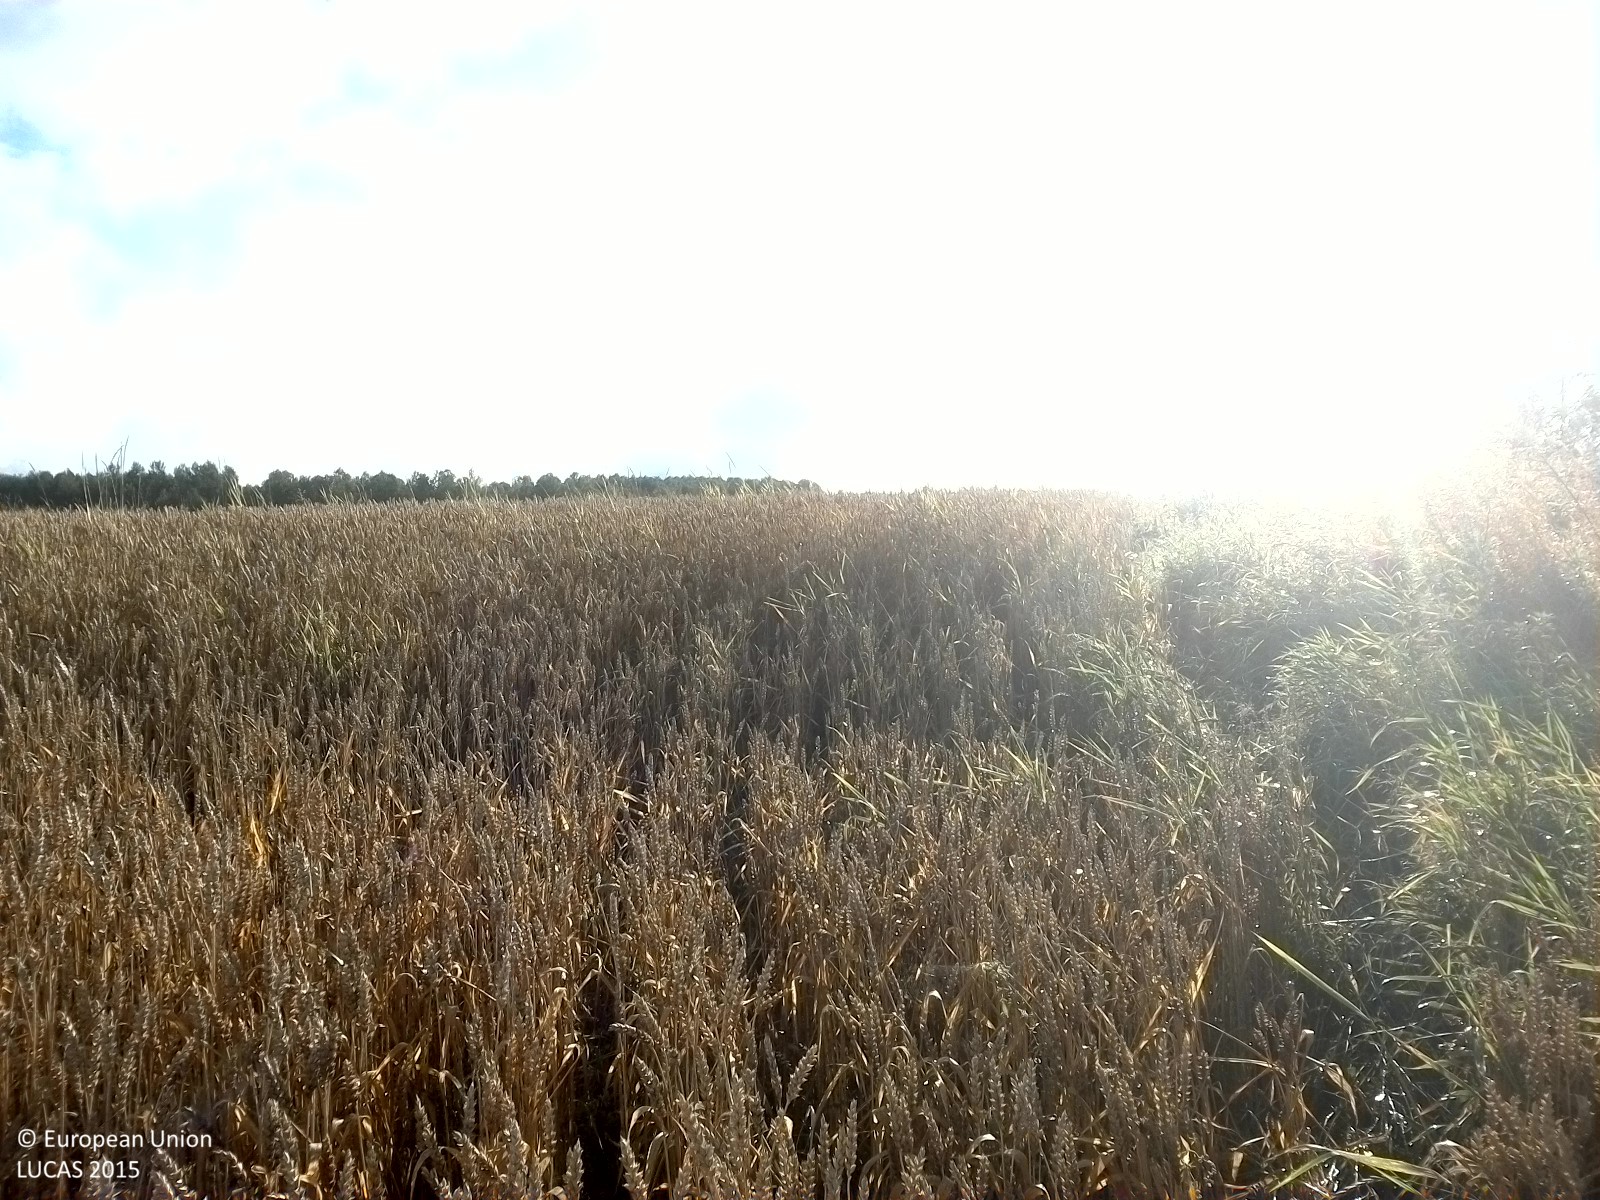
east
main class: Cropland
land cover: Common wheat
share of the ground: > 75 %
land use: Agriculture (excluding fallow land and kitchen gardens)
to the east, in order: Common wheat; Electric lines; Common wheat; Grass margins; Ditches and canals; Grass margins; Paved roads, cycling and walking lanes; Grass margins; Ditches and canals; Grass margins; Barley
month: August
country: SE
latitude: 58.9201
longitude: 15.4635
